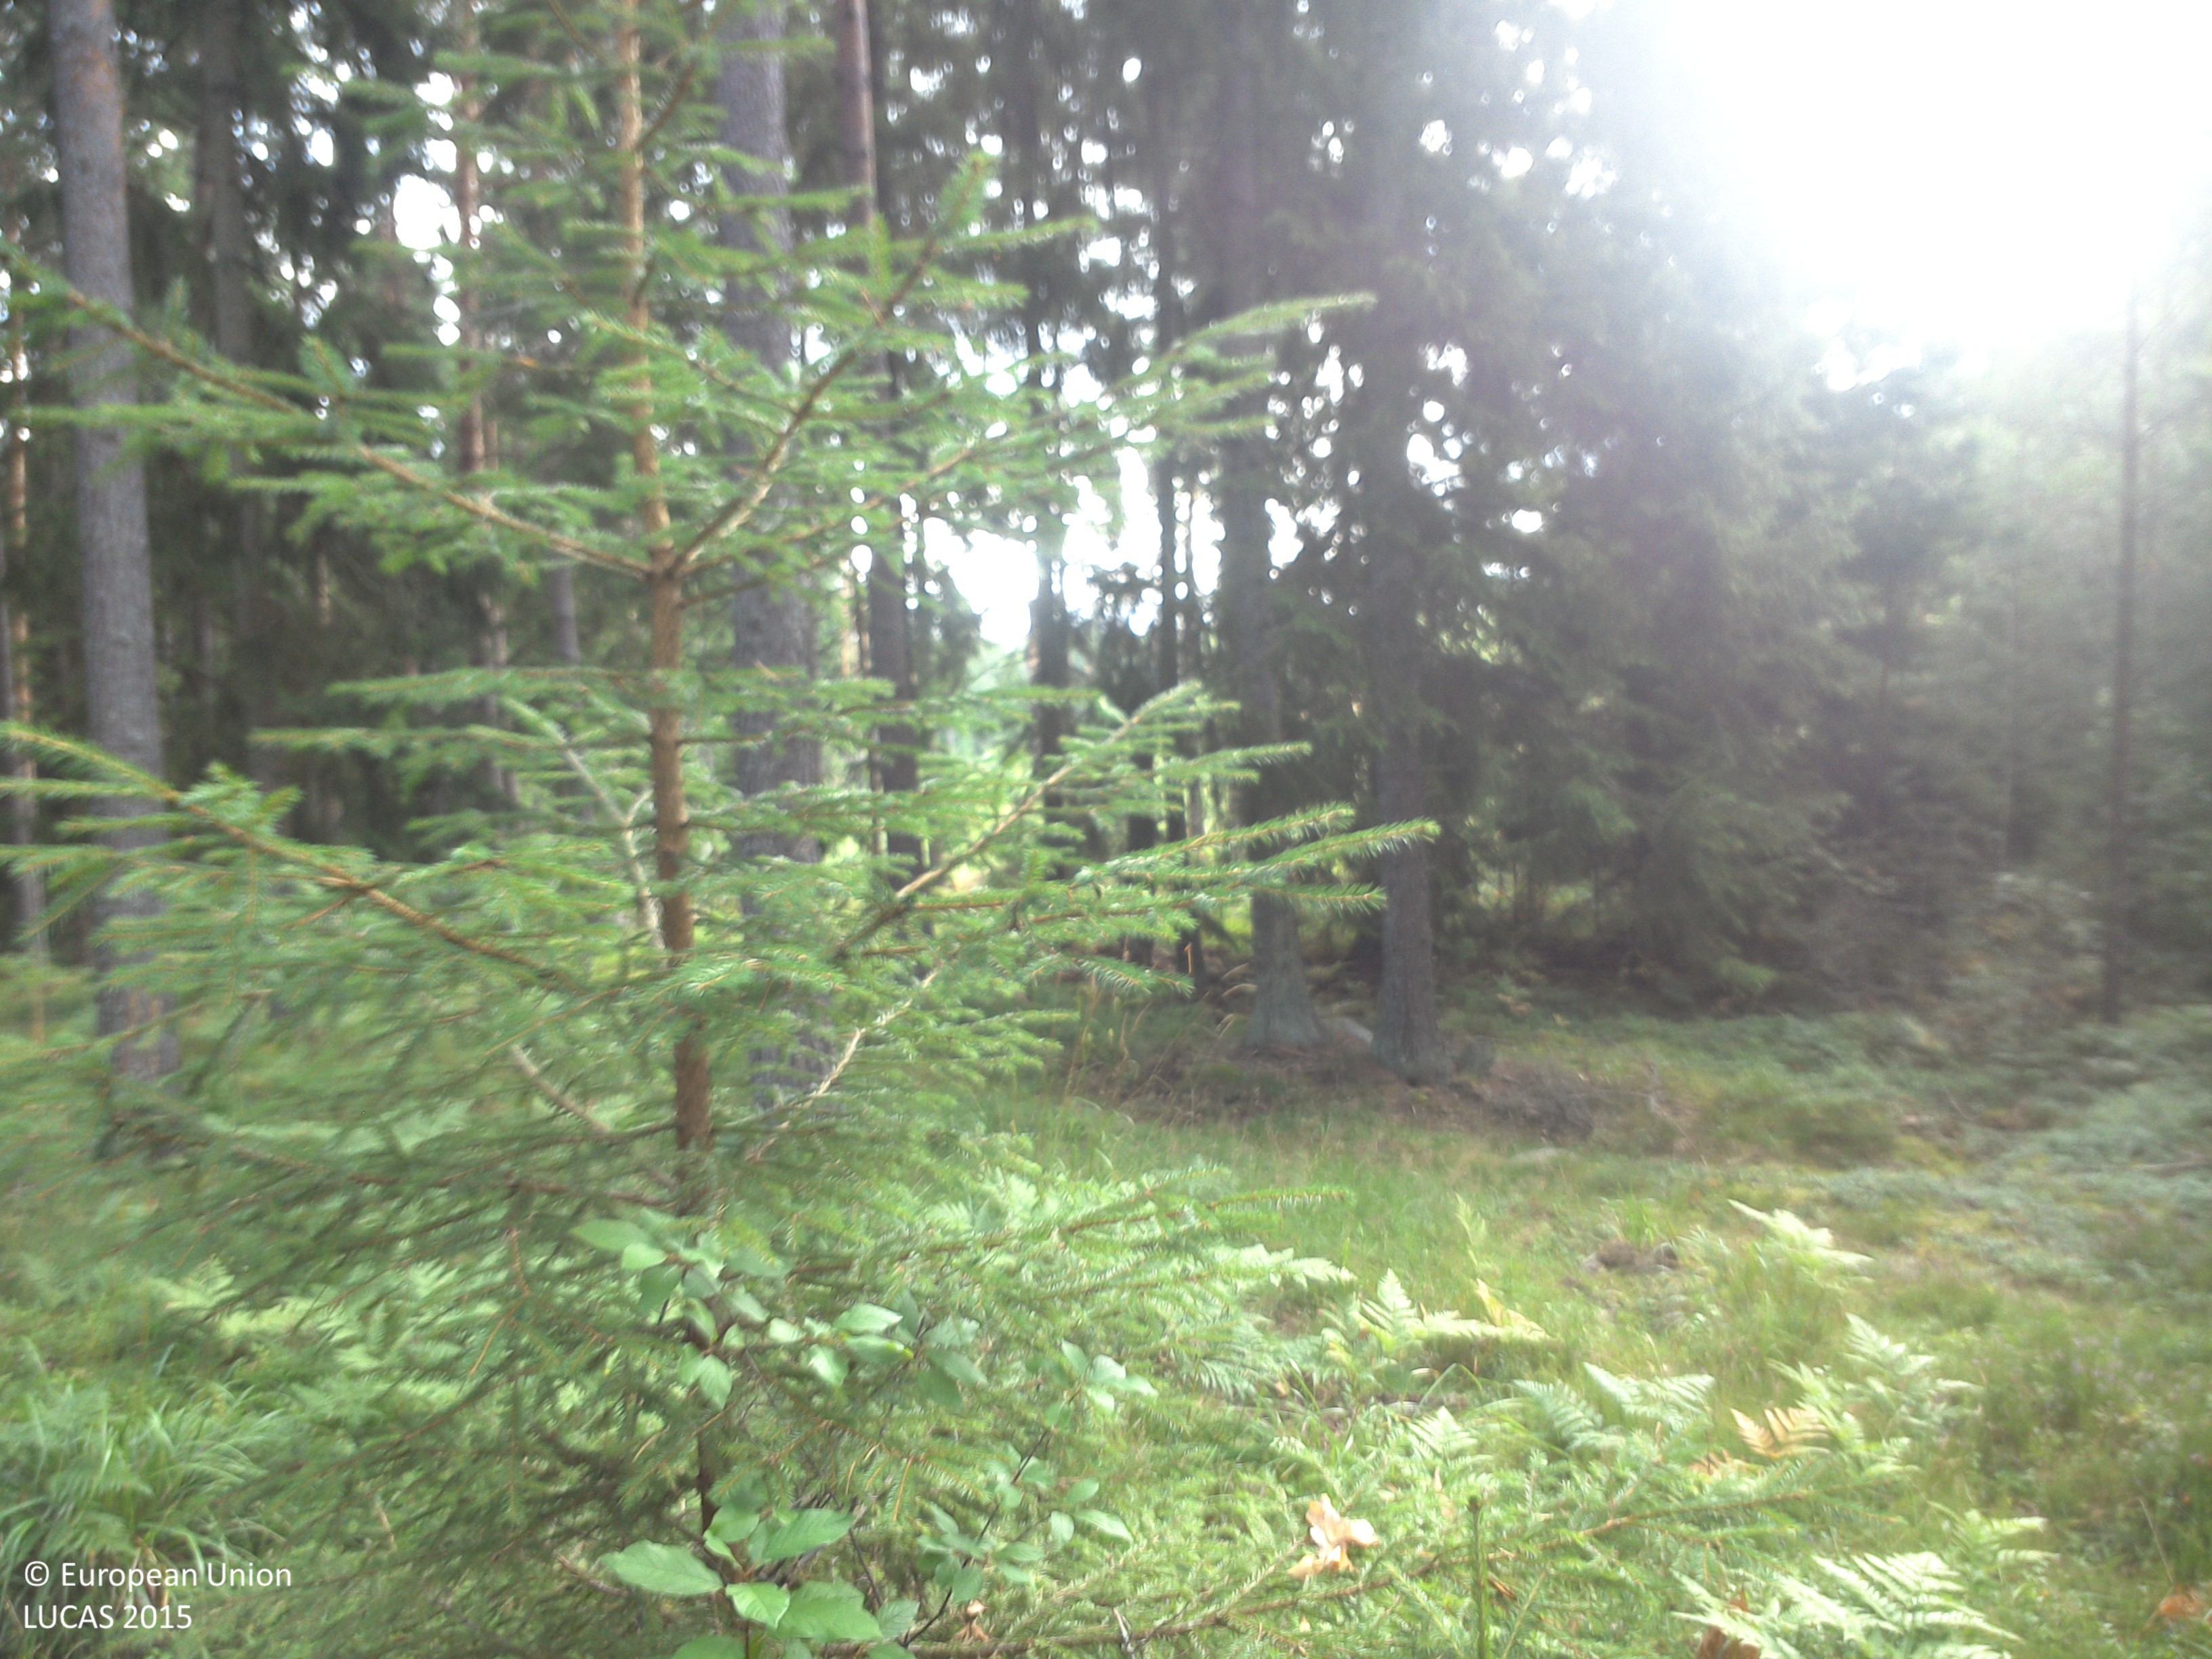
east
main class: Woodland
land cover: Pine dominated coniferous woodland
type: boreal forest
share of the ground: 25 - 50 %
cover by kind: herbaceous plants 50 %, coniferous forest trees 40 %, lichens and mosses 10 %
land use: Forestry
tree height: > 5 m
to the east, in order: Pine dominated coniferous woodland; Broadleaved woodland; Pine dominated coniferous woodland; Broadleaved woodland; Ditches and canals; Spruce dominated mixed woodland
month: August
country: SE
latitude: 58.0183
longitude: 15.4632
